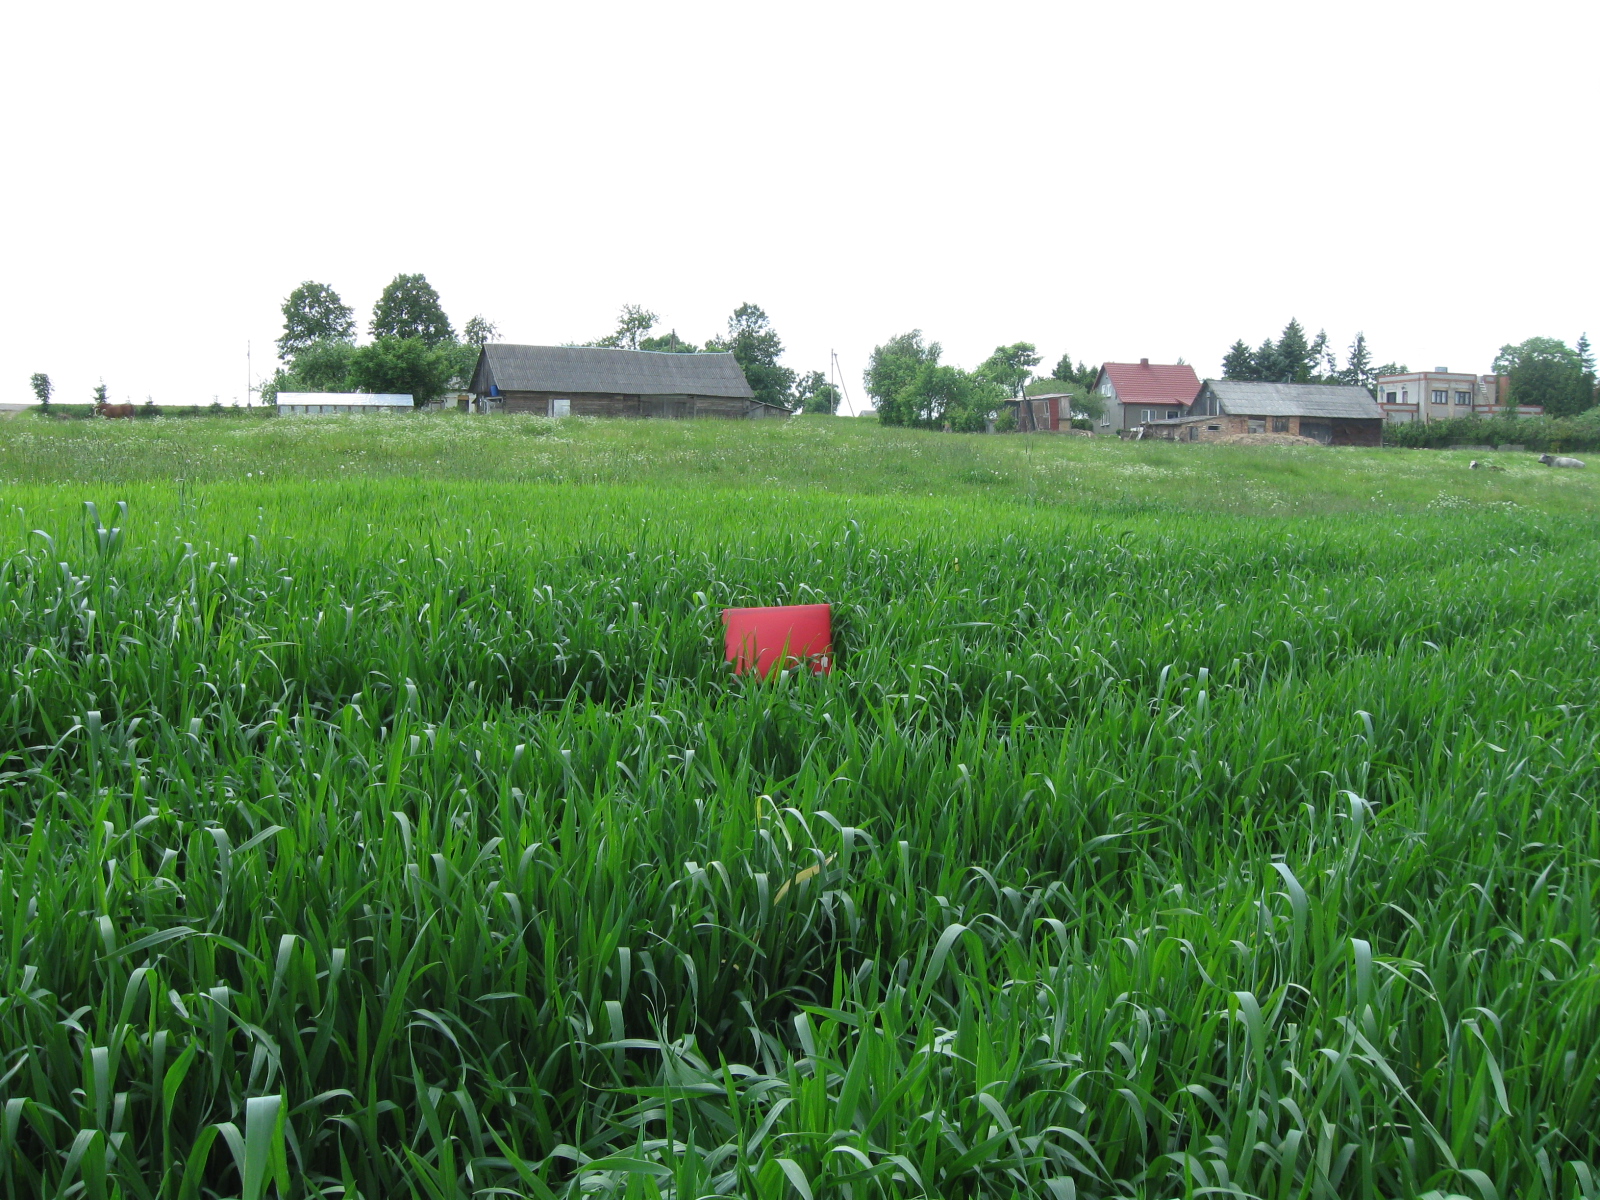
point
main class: Cropland
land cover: Common wheat
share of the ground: > 75 %
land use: Agriculture (excluding fallow land and kitchen gardens)
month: June
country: LT
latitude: 54.3419
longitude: 23.7935
